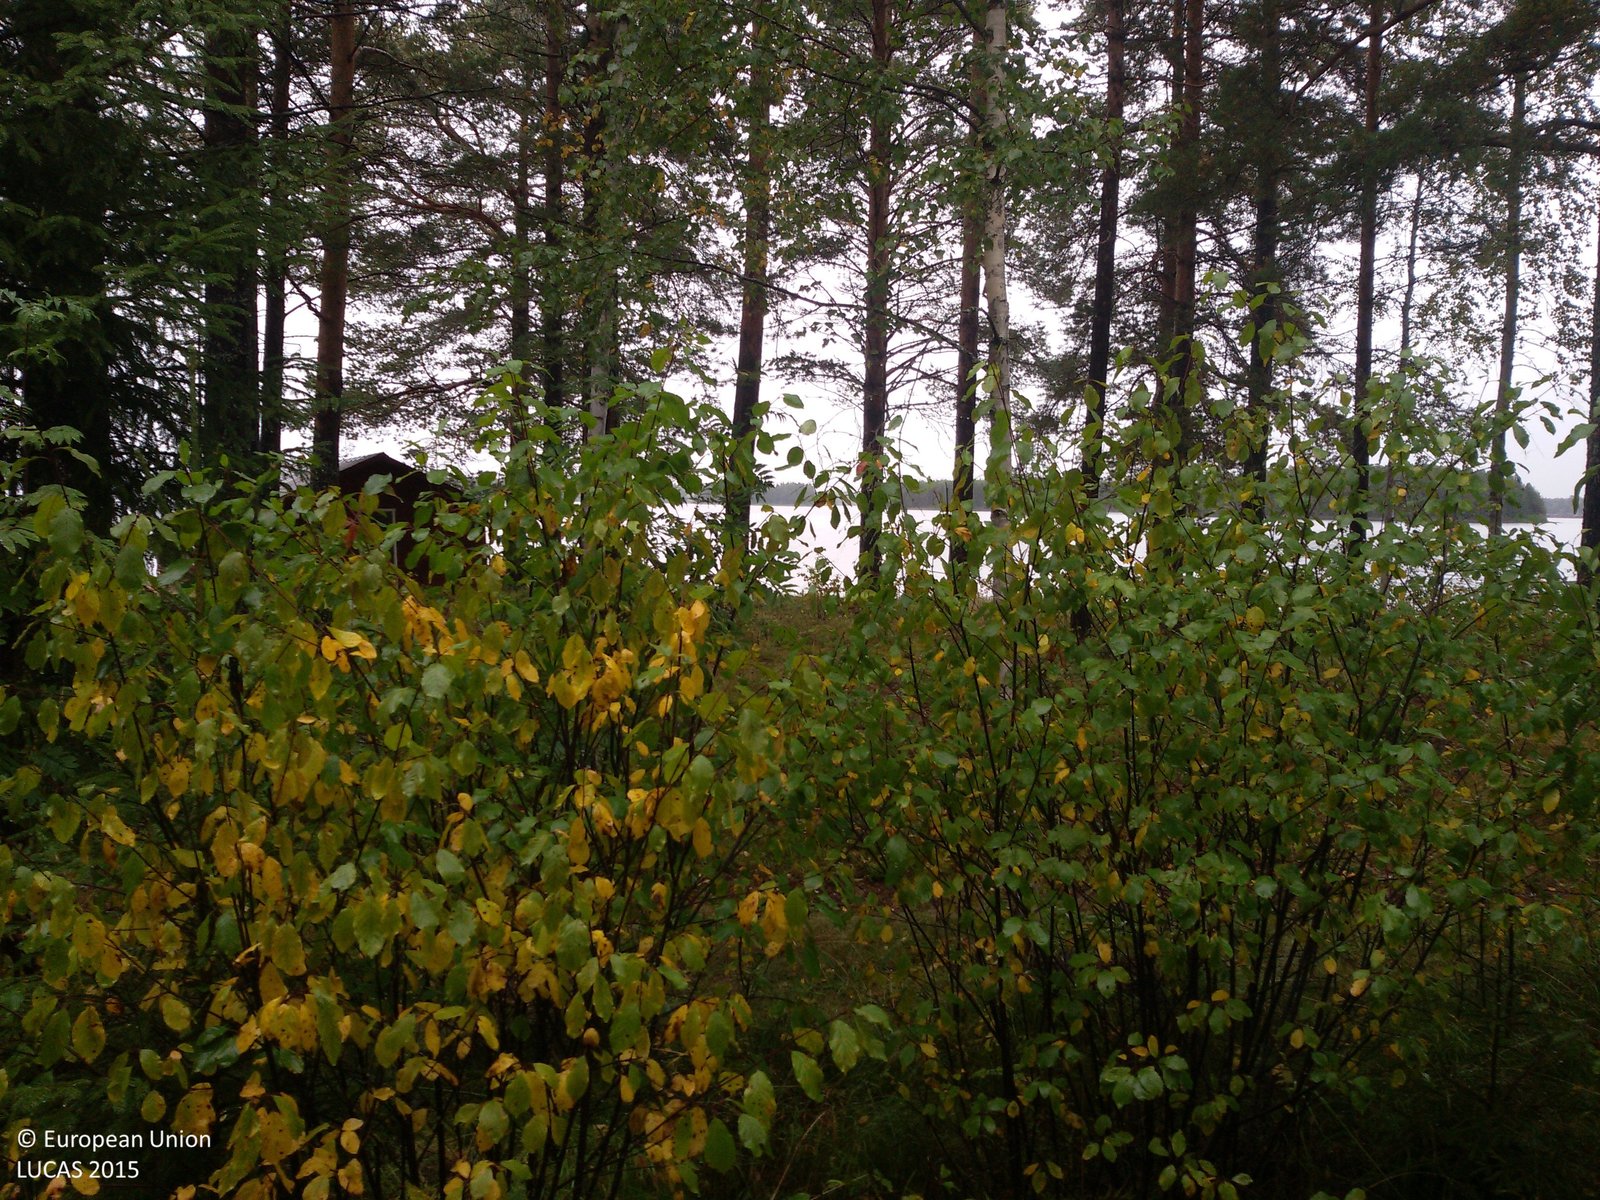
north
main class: Woodland
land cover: Spruce dominated mixed woodland
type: boreal forest
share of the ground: 50 - 75 %
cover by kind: coniferous forest trees 40 %, broadleaved forest trees 30 %, herbaceous plants 20 %, shrubs 10 %
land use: Amenities, museums, leisure
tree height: > 5 m
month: September
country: SE
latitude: 60.8822
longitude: 14.5742
